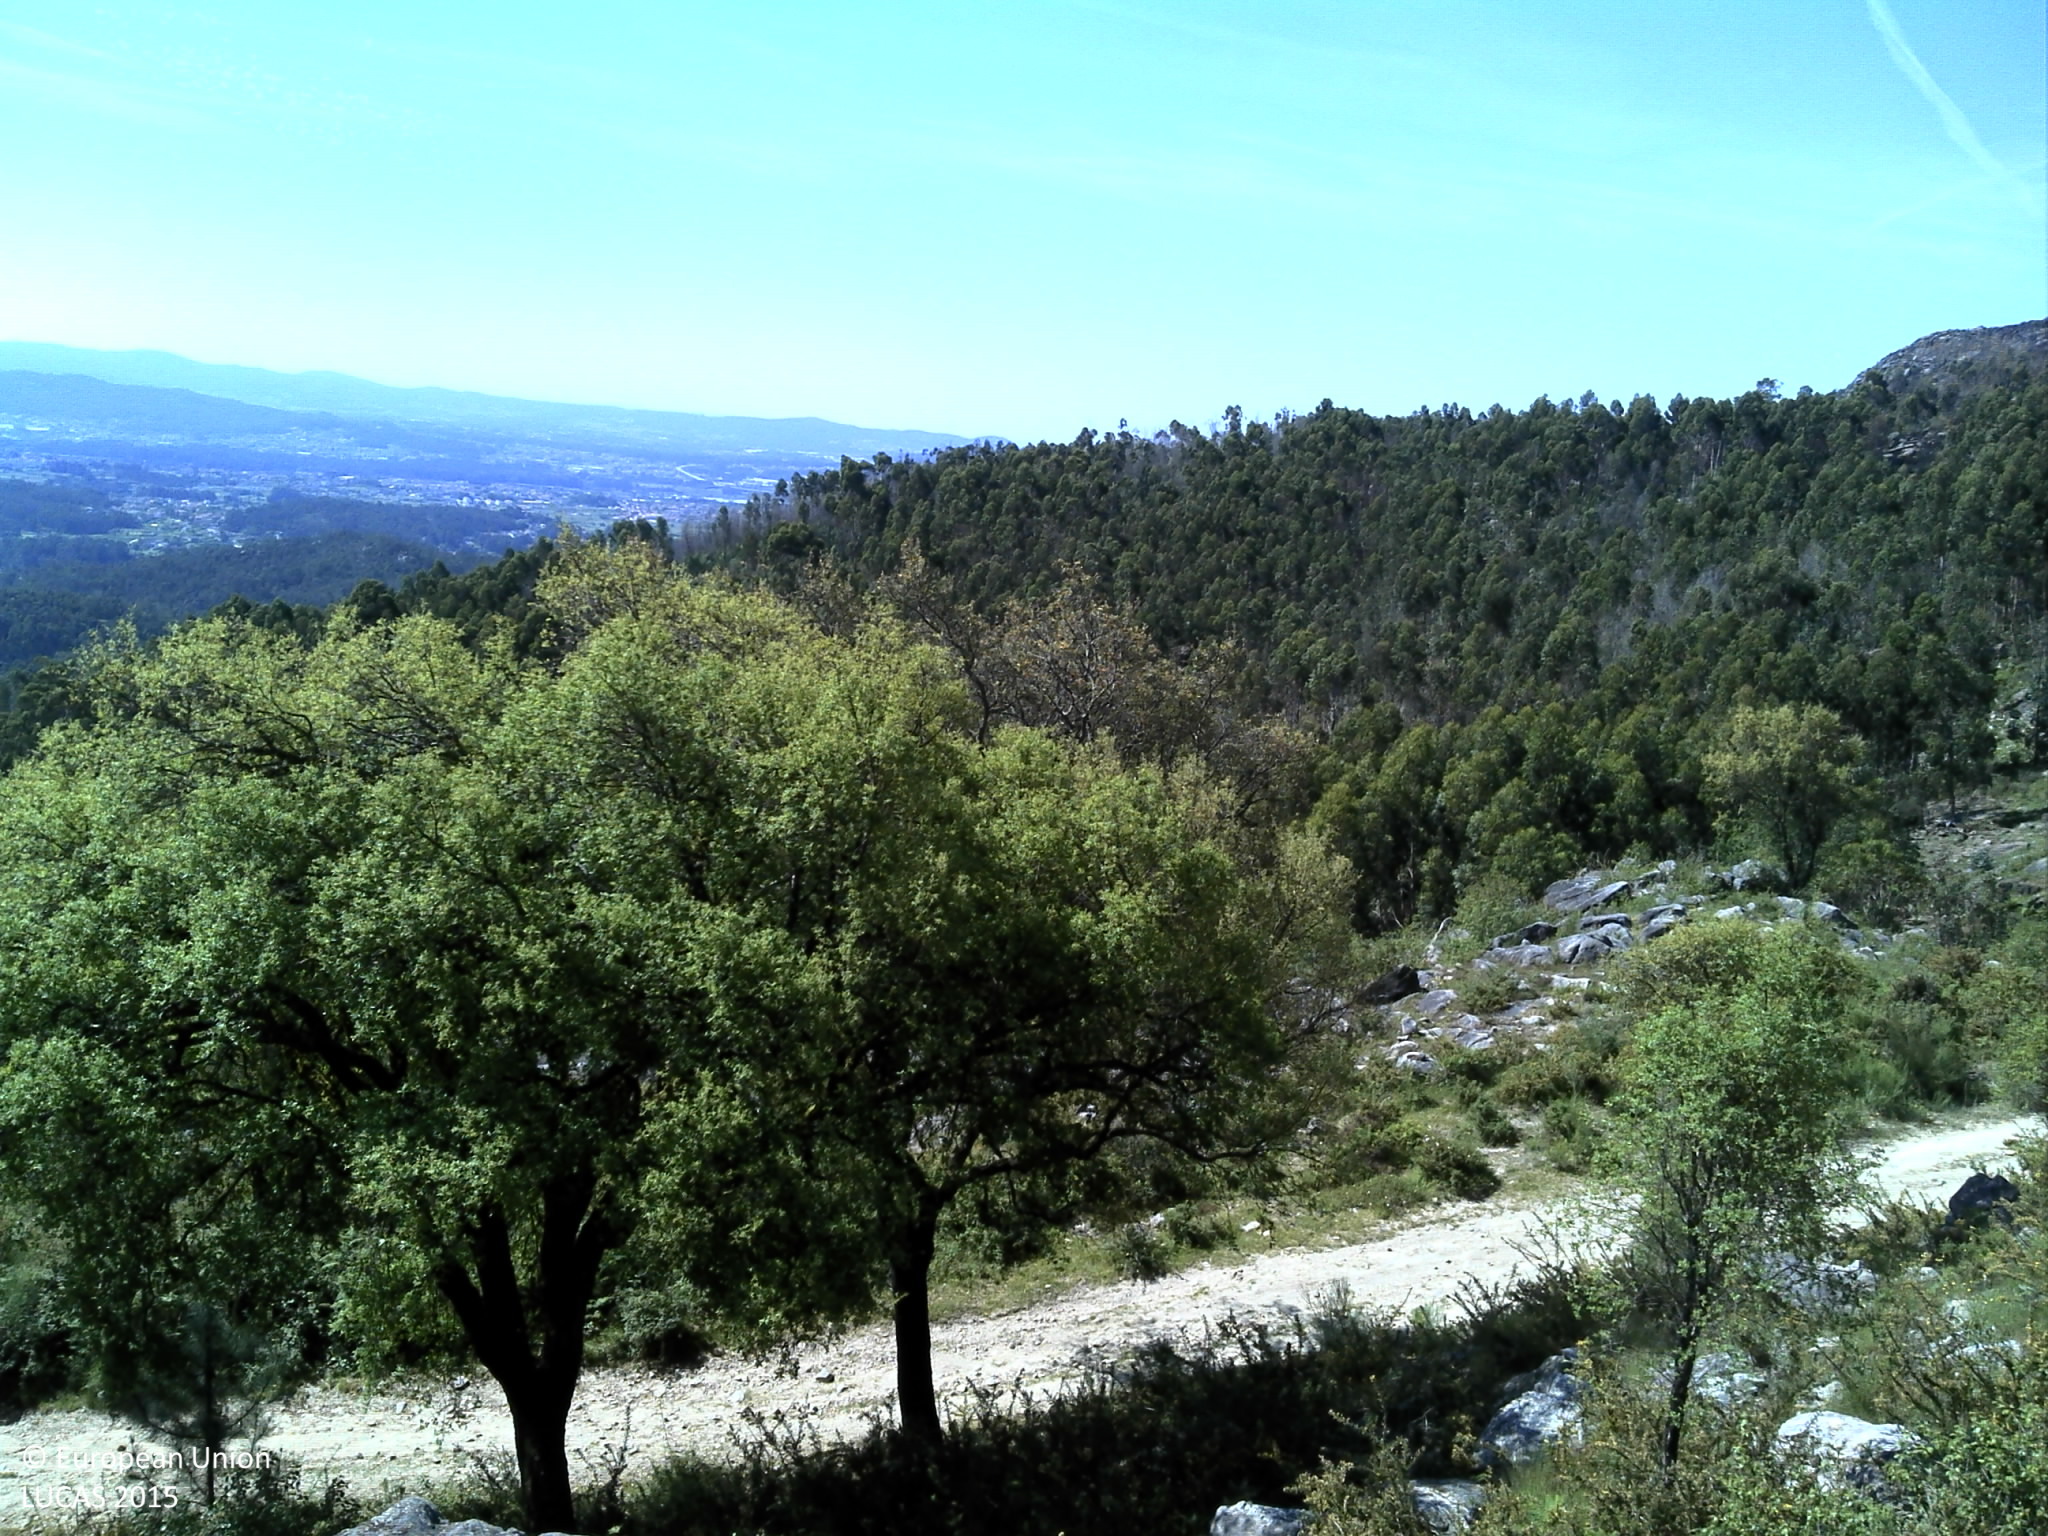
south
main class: Shrubland
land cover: Shrubland without tree cover
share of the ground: > 75 %
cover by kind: shrubs 80 %, unconsolidated bare surface 20 %
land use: Semi-natural and natural areas not in use
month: May
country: PT
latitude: 41.7623
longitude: -8.8003
